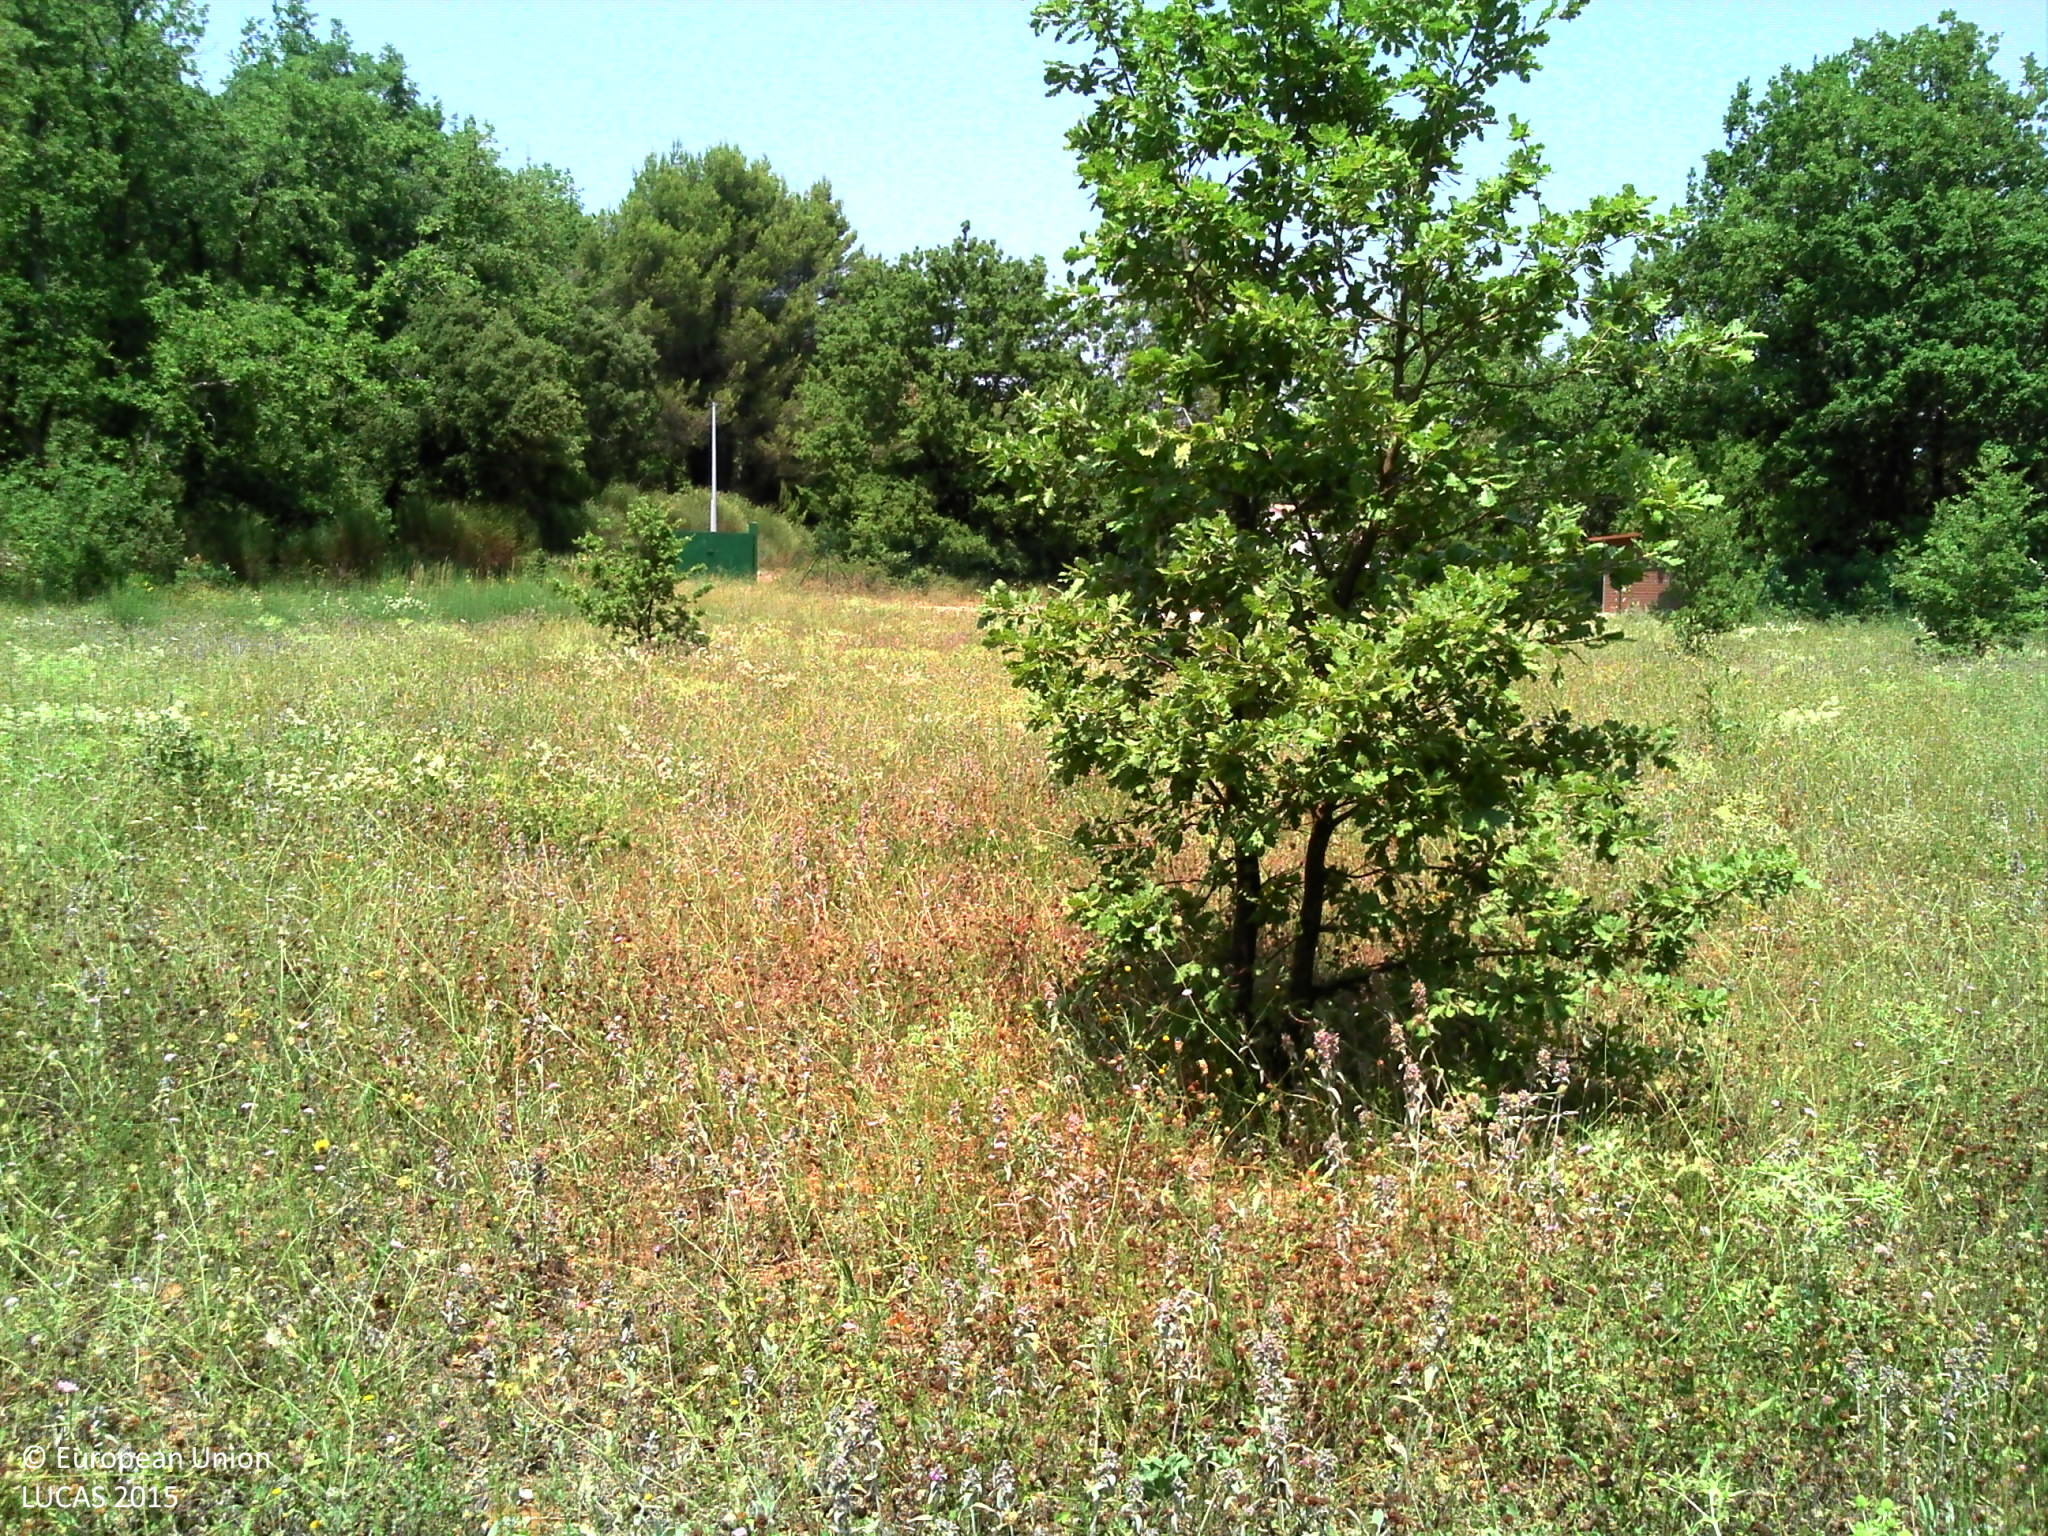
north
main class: Grassland
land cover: Grassland with sparse tree/shrub cover
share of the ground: > 75 %
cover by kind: herbaceous plants 95 %, broadleaved forest trees 5 %
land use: Semi-natural and natural areas not in use
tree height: < 5 m
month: July
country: FR
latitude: 43.3614
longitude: 5.7774
